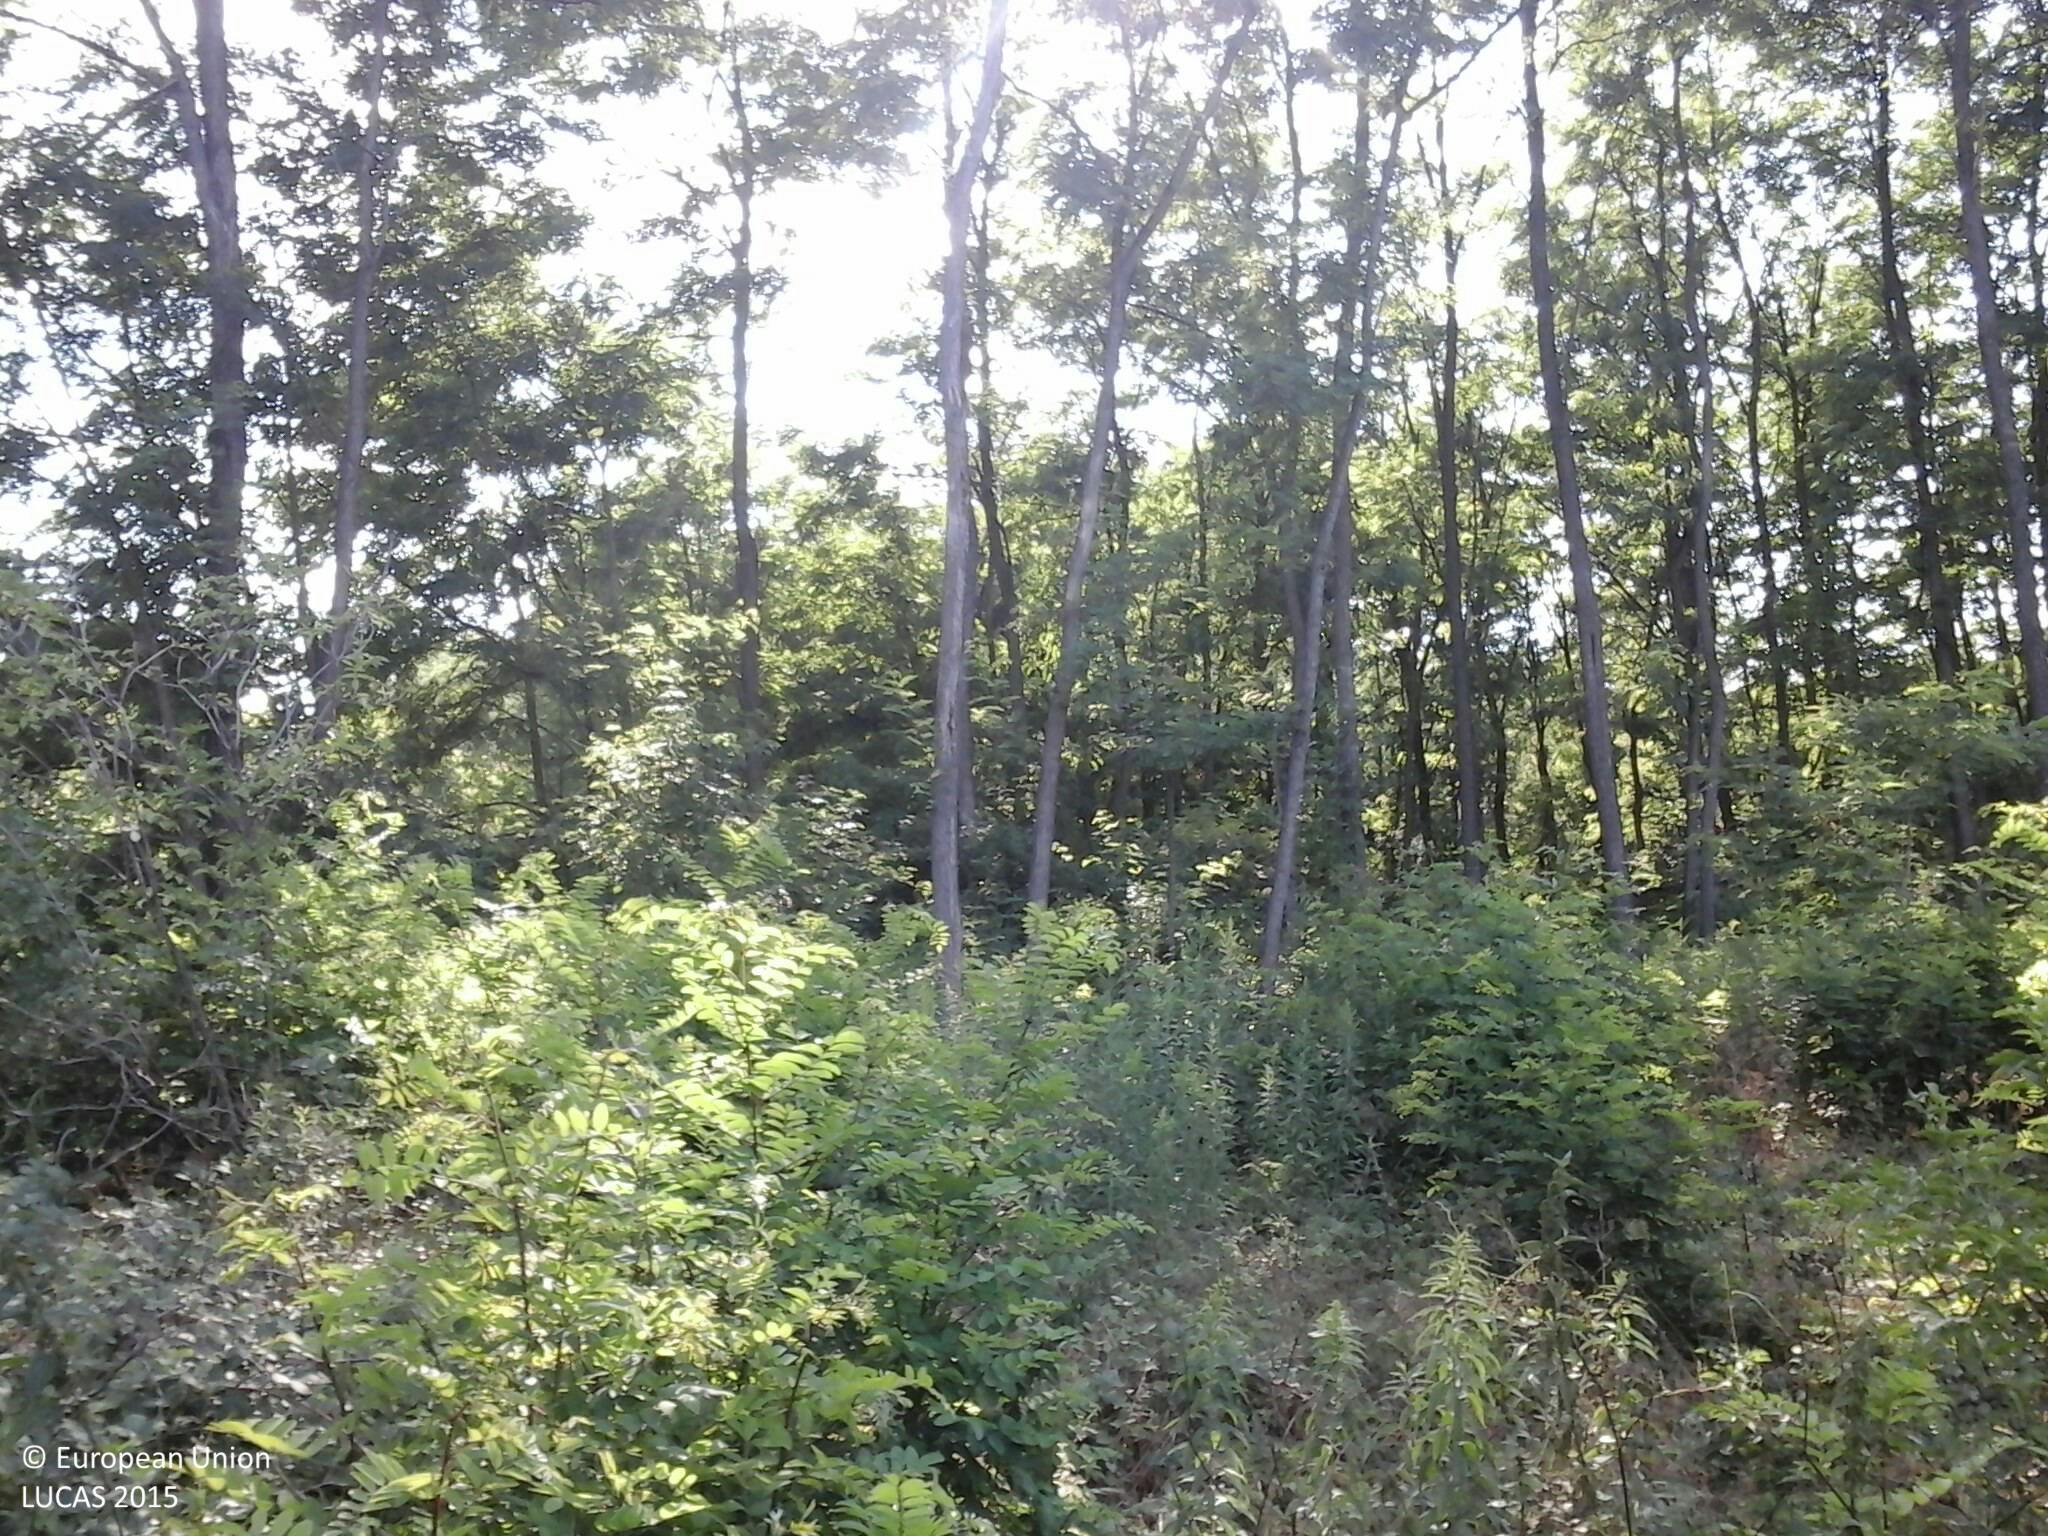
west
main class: Woodland
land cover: Broadleaved woodland
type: exotic forest
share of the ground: > 75 %
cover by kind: broadleaved forest trees 75 %, herbaceous plants 15 %, shrubs 10 %
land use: Forestry
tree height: > 5 m
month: July
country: HU
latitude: 46.9747
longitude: 17.2218
